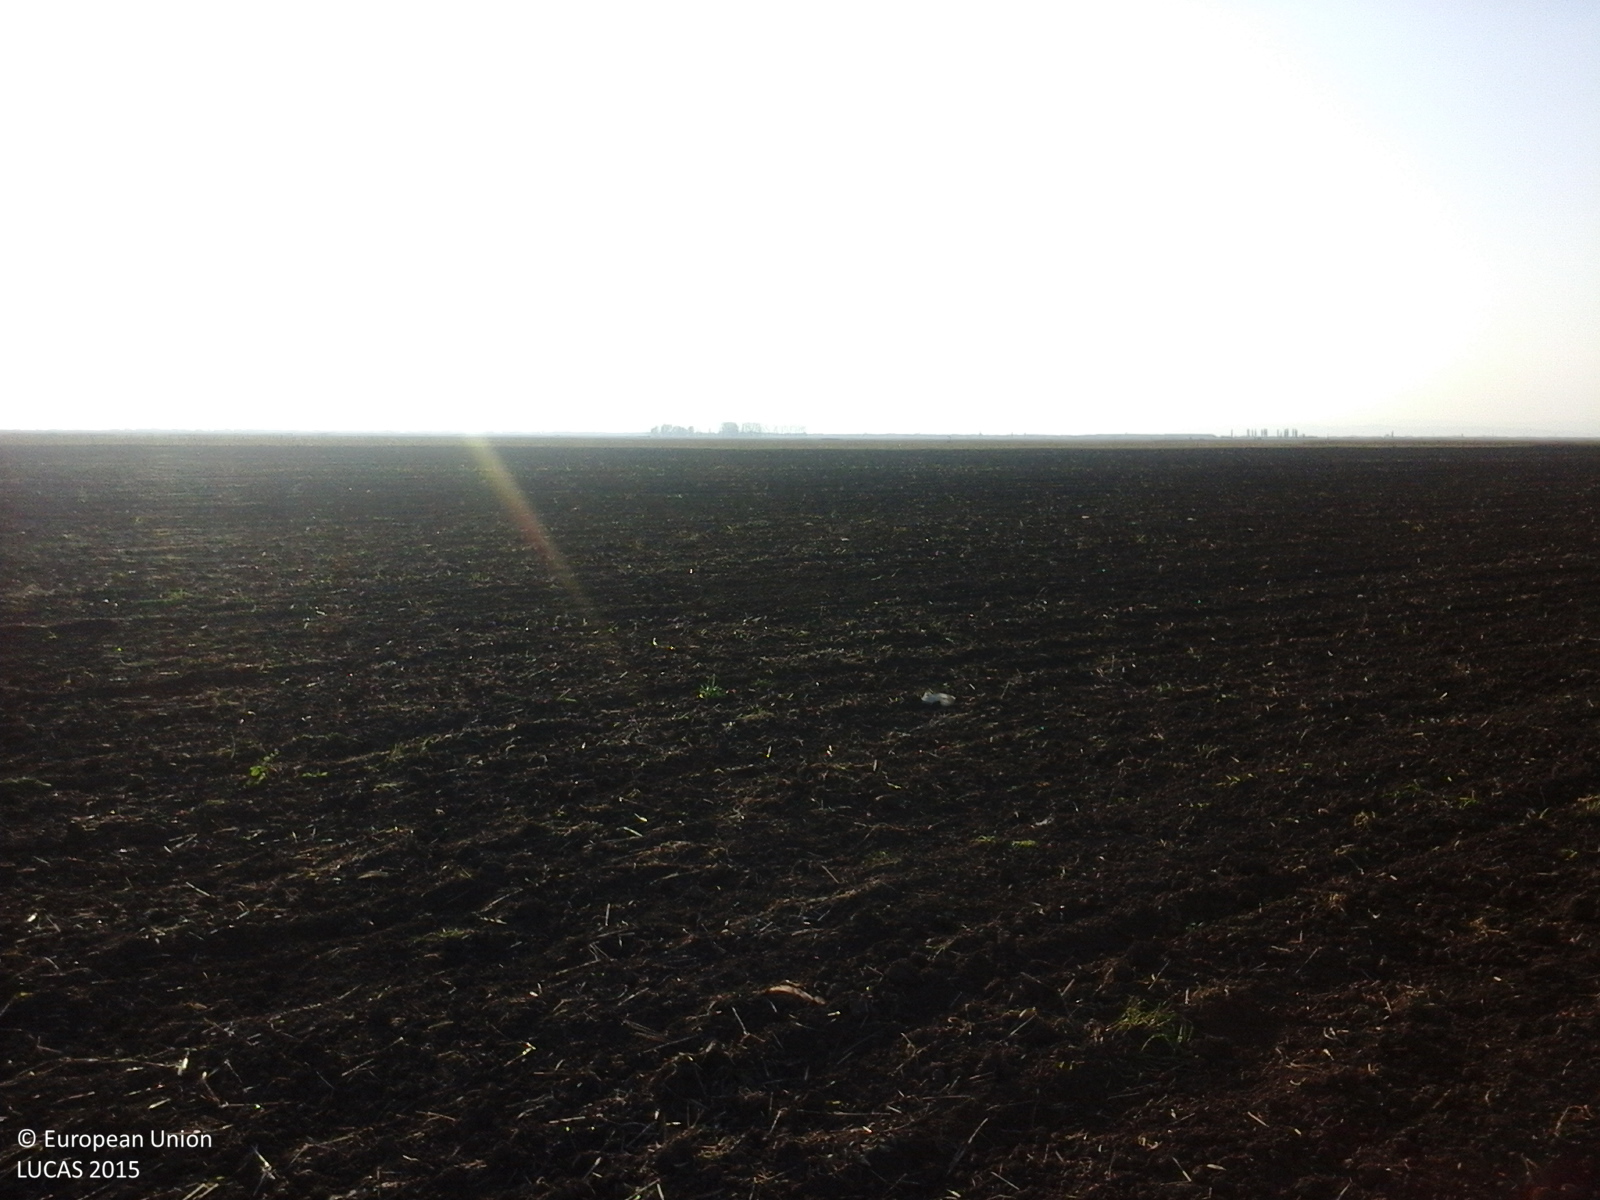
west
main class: Cropland
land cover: Common wheat
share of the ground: < 10 %
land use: Agriculture (excluding fallow land and kitchen gardens)
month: October
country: RO
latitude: 45.1709
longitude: 26.9423
